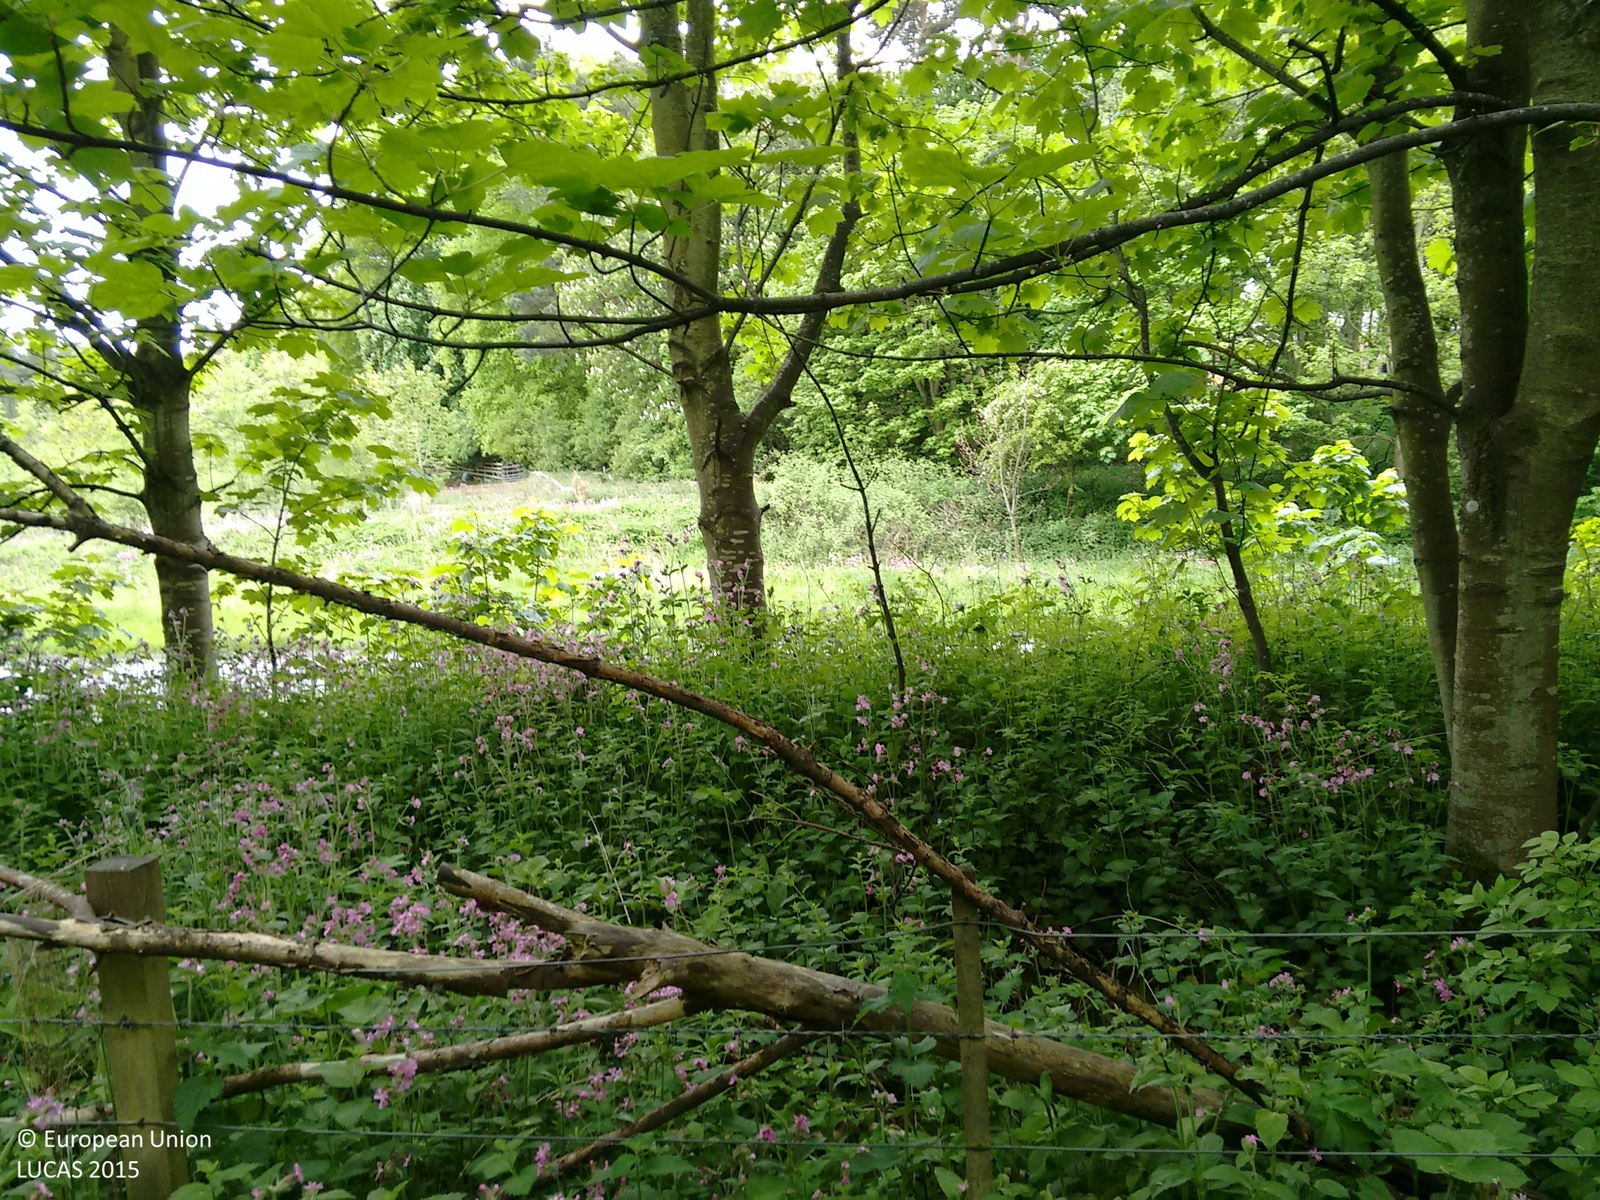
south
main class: Woodland
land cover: Broadleaved woodland
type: hemiboreal forest and nemoral coniferous forest and mixed broadleaved-coniferous forest
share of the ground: > 75 %
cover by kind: broadleaved forest trees 80 %, coniferous forest trees 10 %, shrubs 5 %, herbaceous plants 5 %
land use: Semi-natural and natural areas not in use
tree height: > 5 m
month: May
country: GB
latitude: 55.8481
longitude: -2.1125
